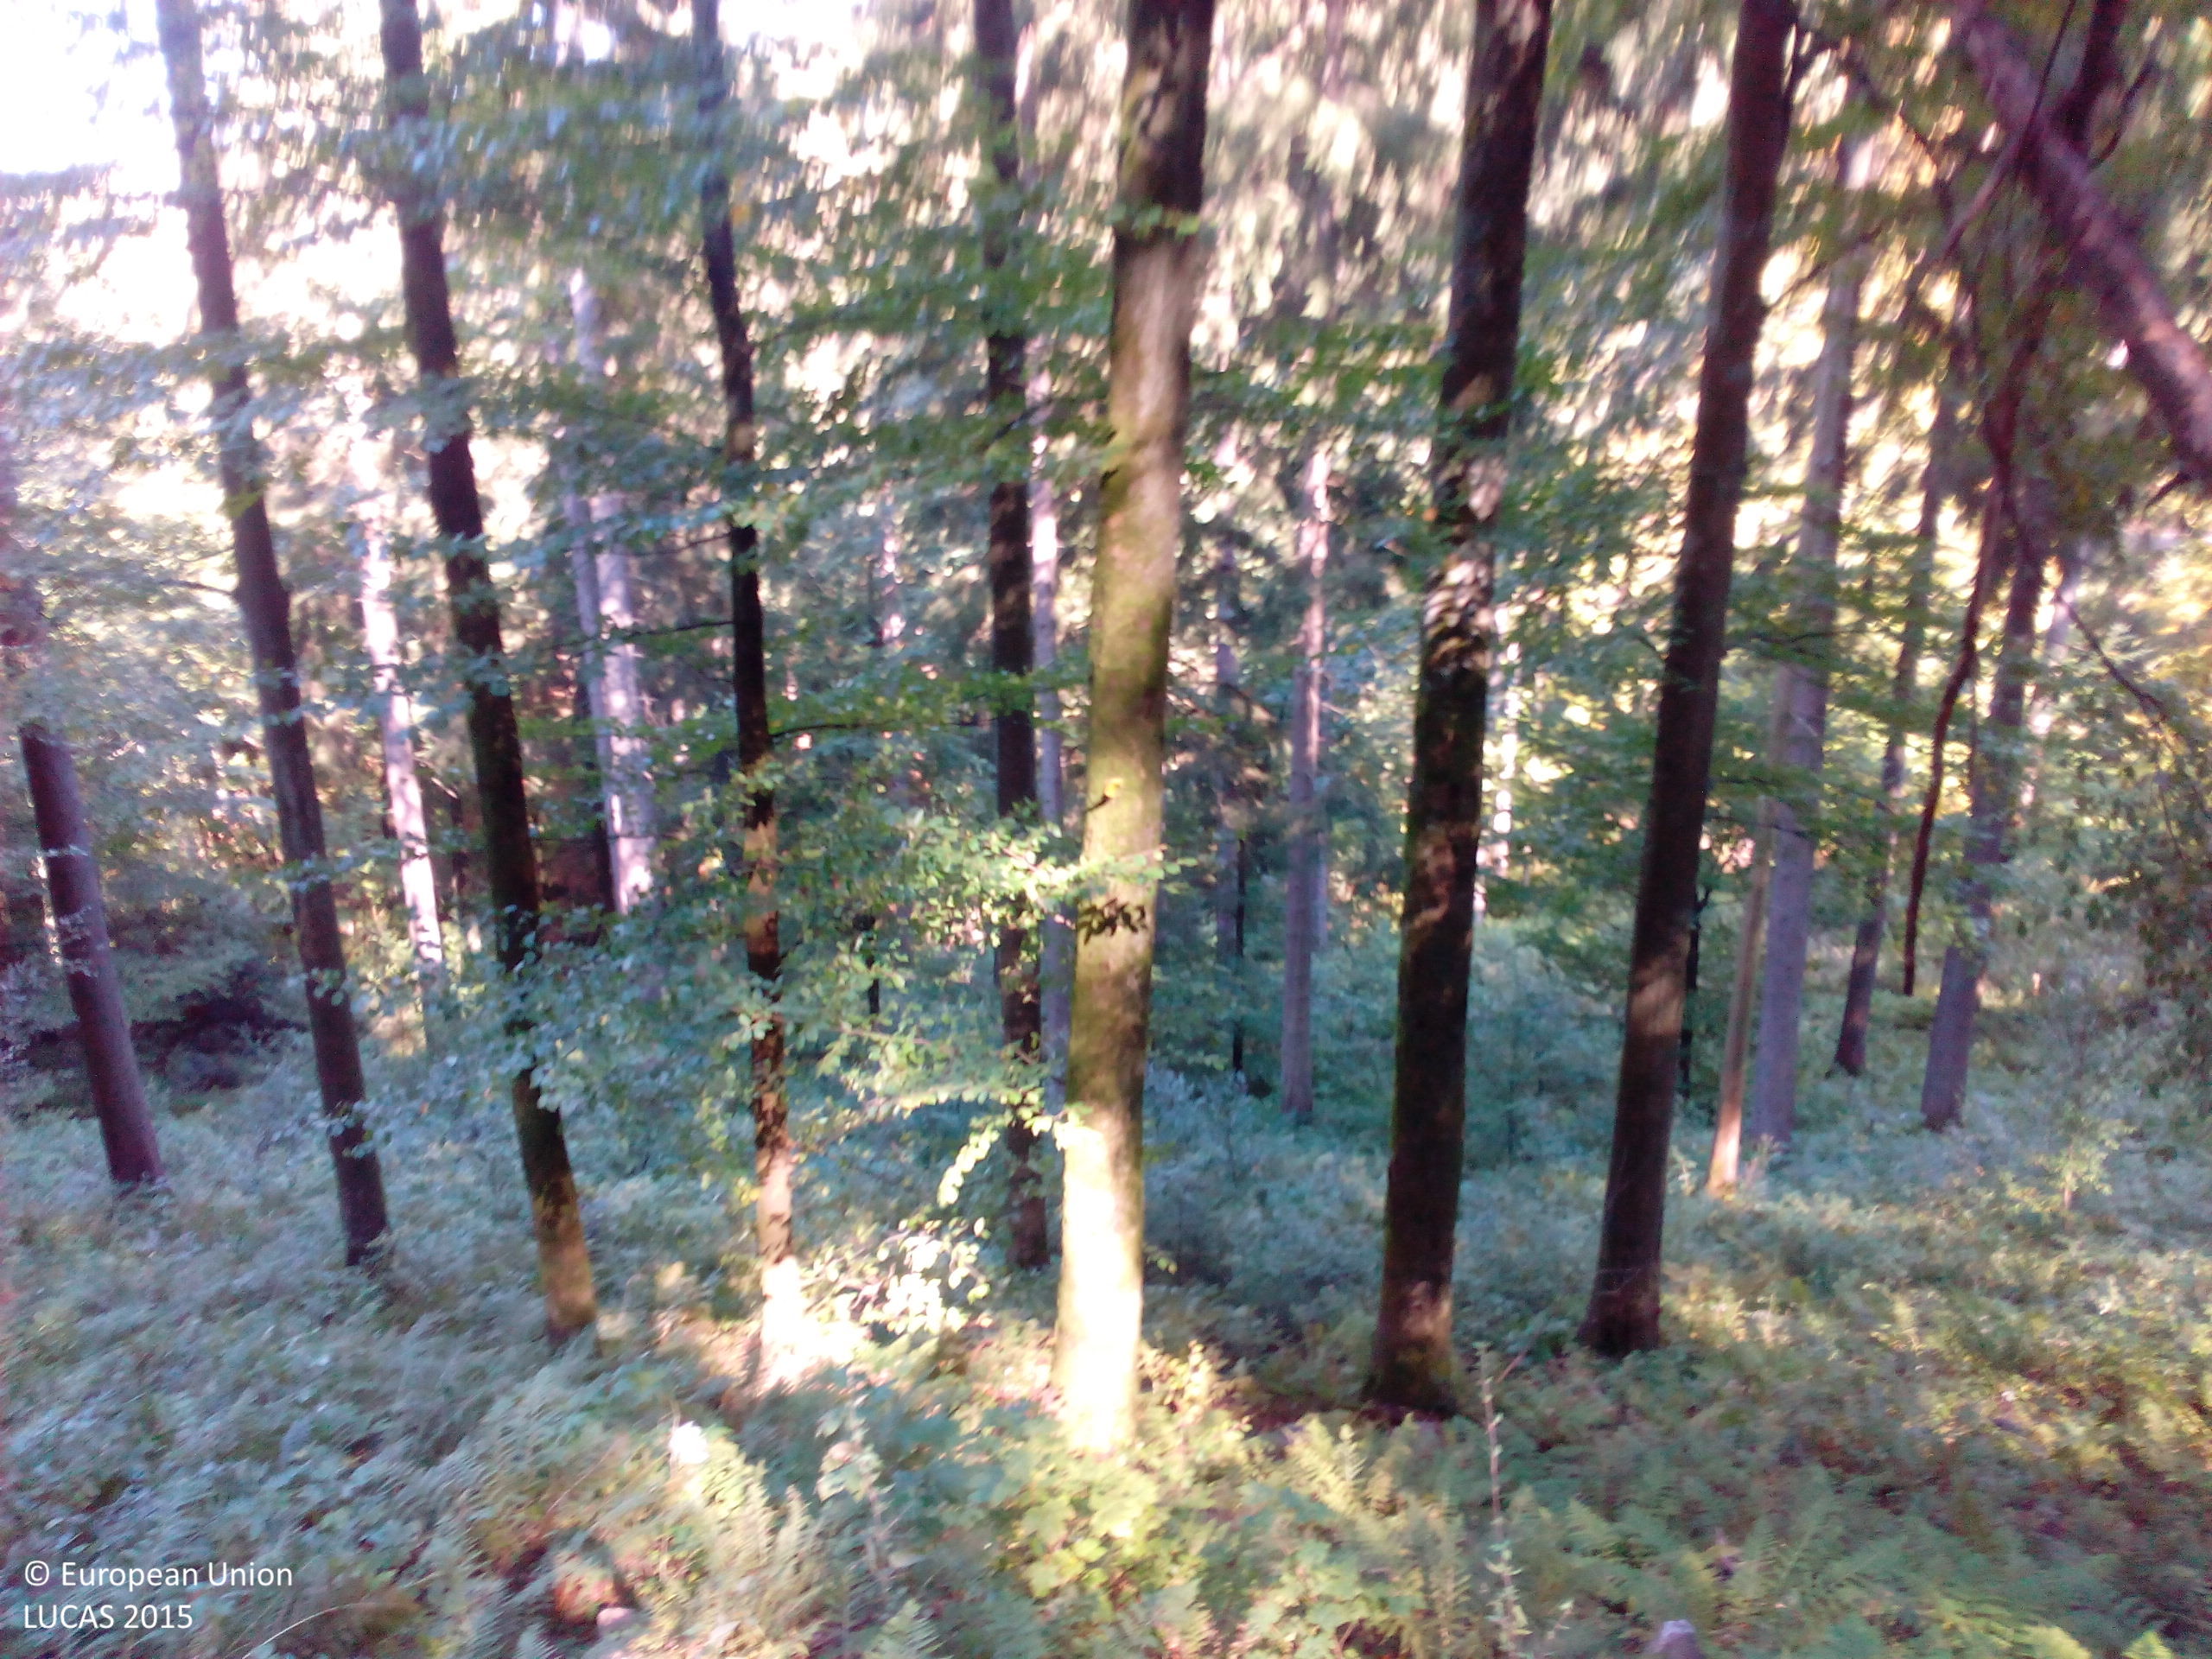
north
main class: Woodland
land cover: Other mixed woodland
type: hemiboreal forest and nemoral coniferous forest and mixed broadleaved-coniferous forest
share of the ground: 50 - 75 %
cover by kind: broadleaved forest trees 40 %, coniferous forest trees 30 %, shrubs 20 %, herbaceous plants 10 %
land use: Forestry
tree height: > 5 m
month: September
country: DE
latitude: 48.6228
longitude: 8.1964
